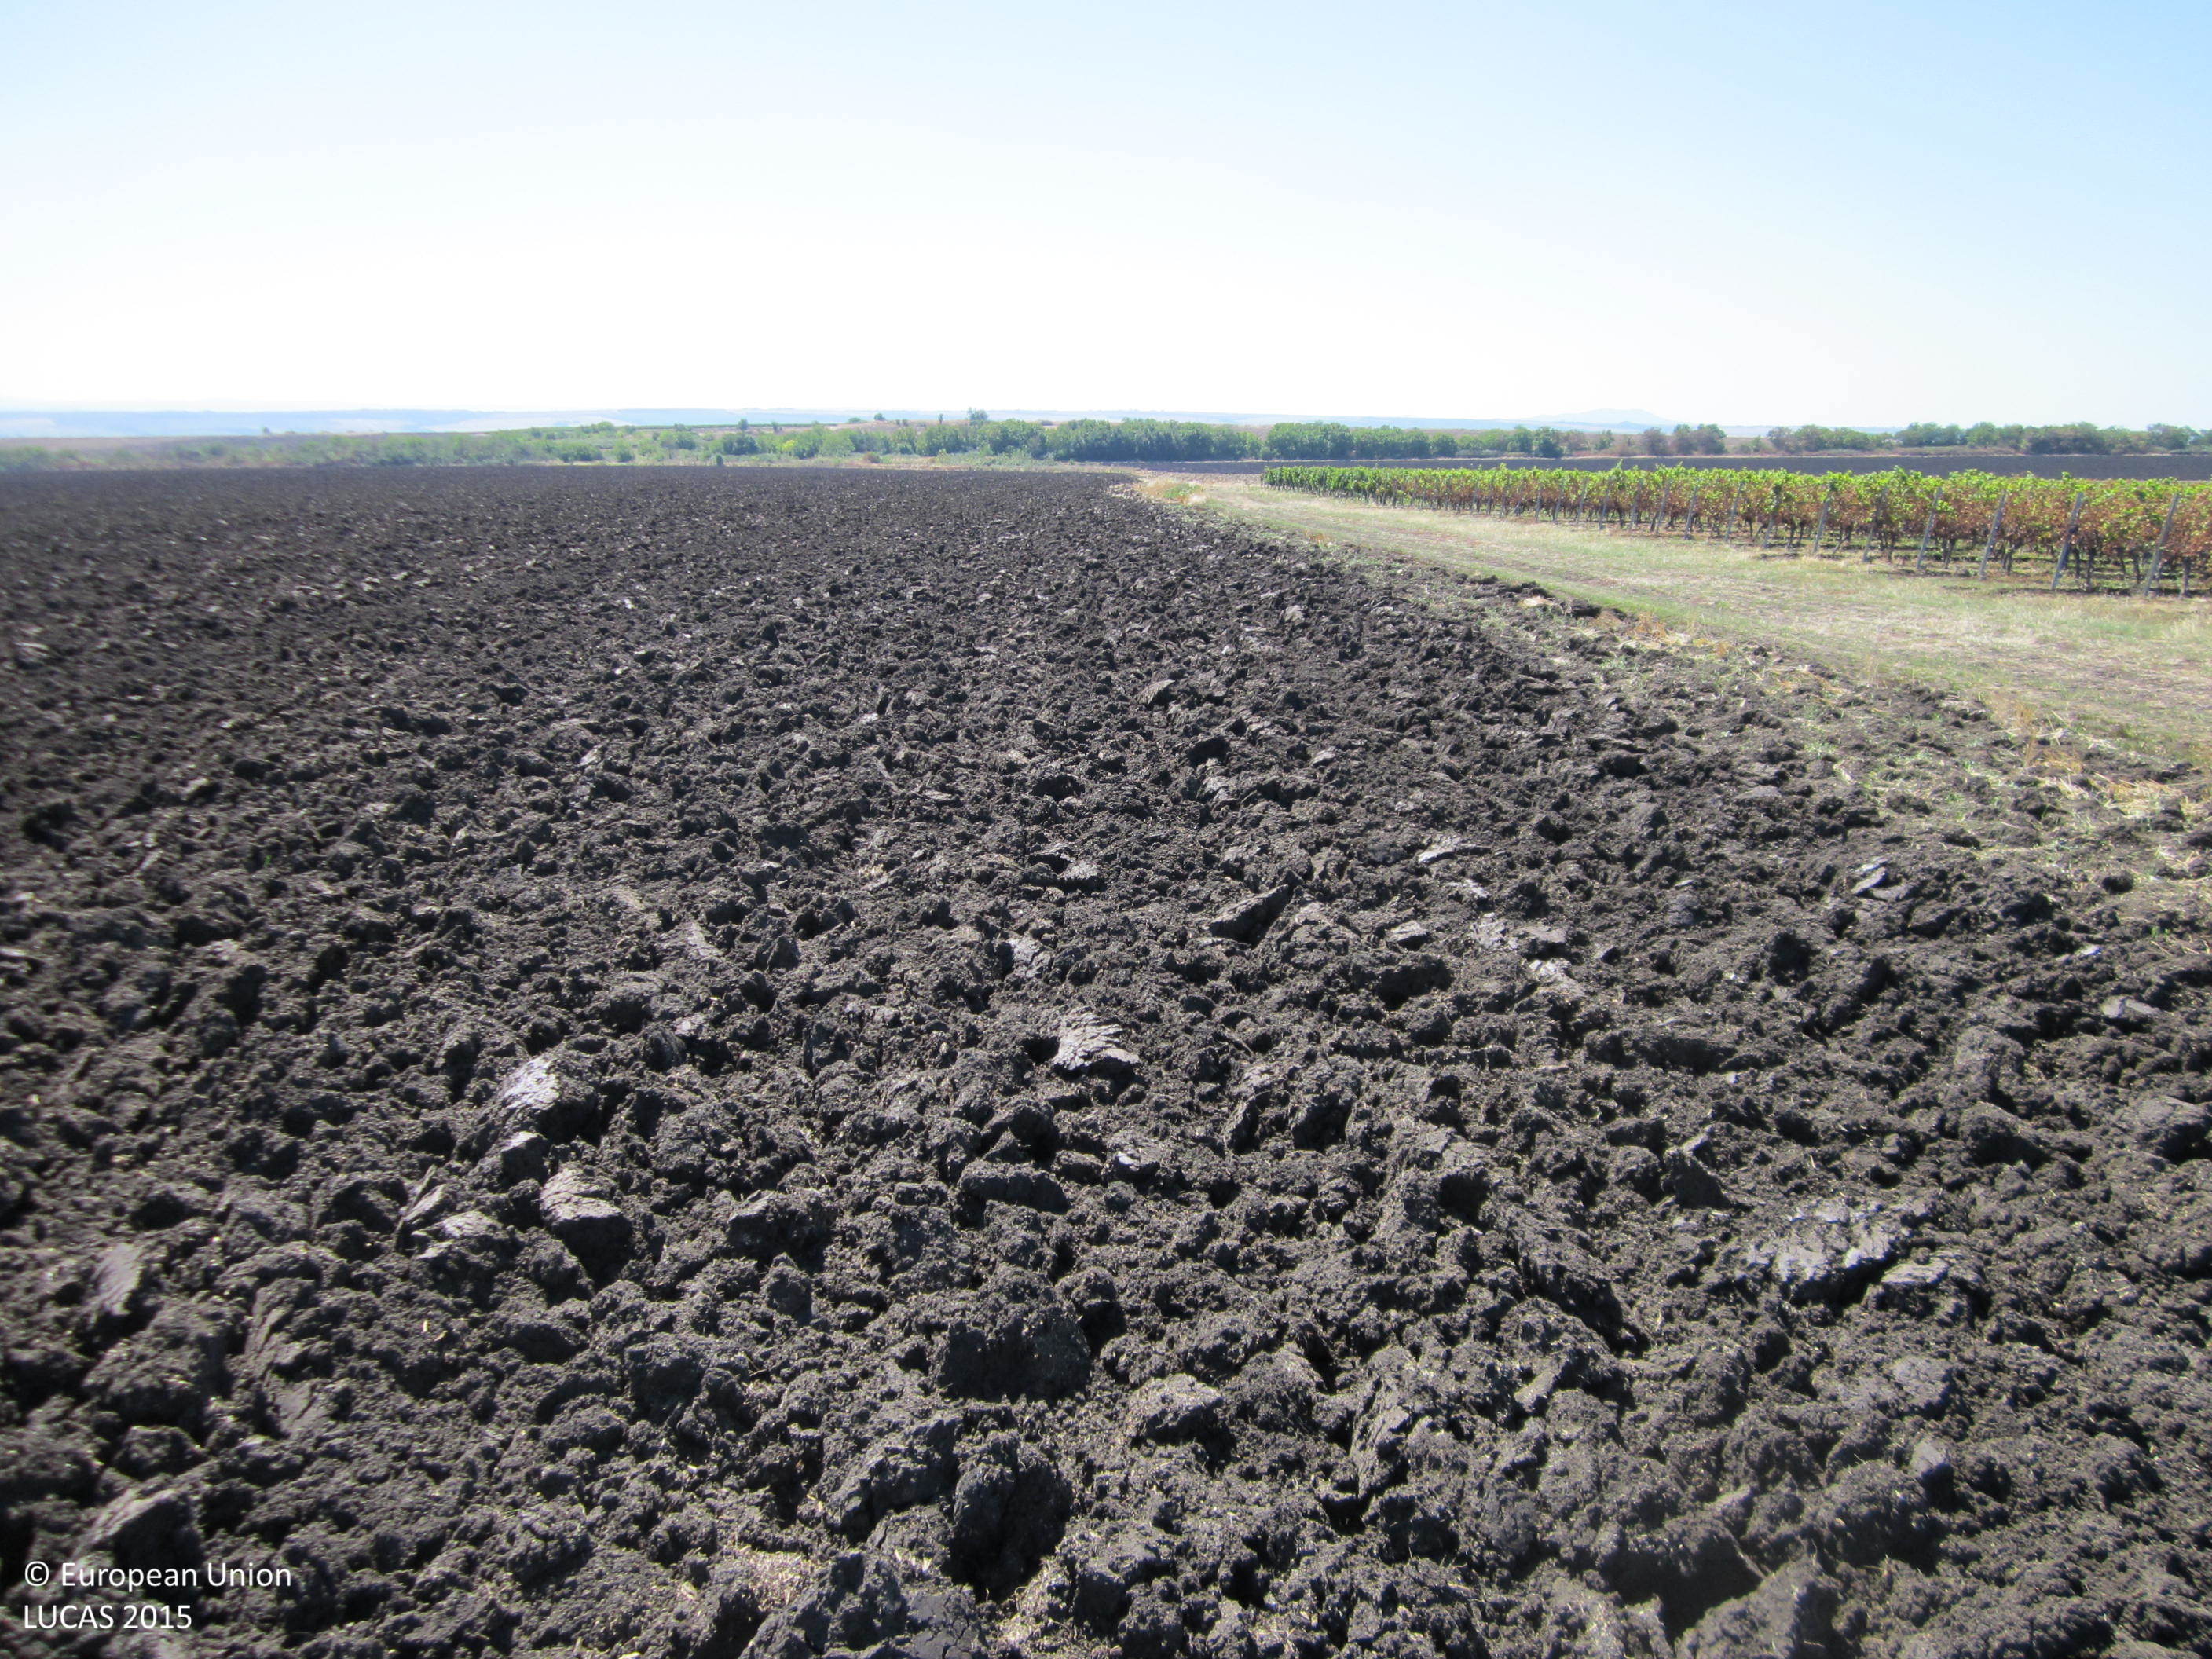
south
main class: Cropland
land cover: Common wheat
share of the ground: < 10 %
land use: Agriculture (excluding fallow land and kitchen gardens)
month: September
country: BG
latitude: 42.5331
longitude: 27.0915
